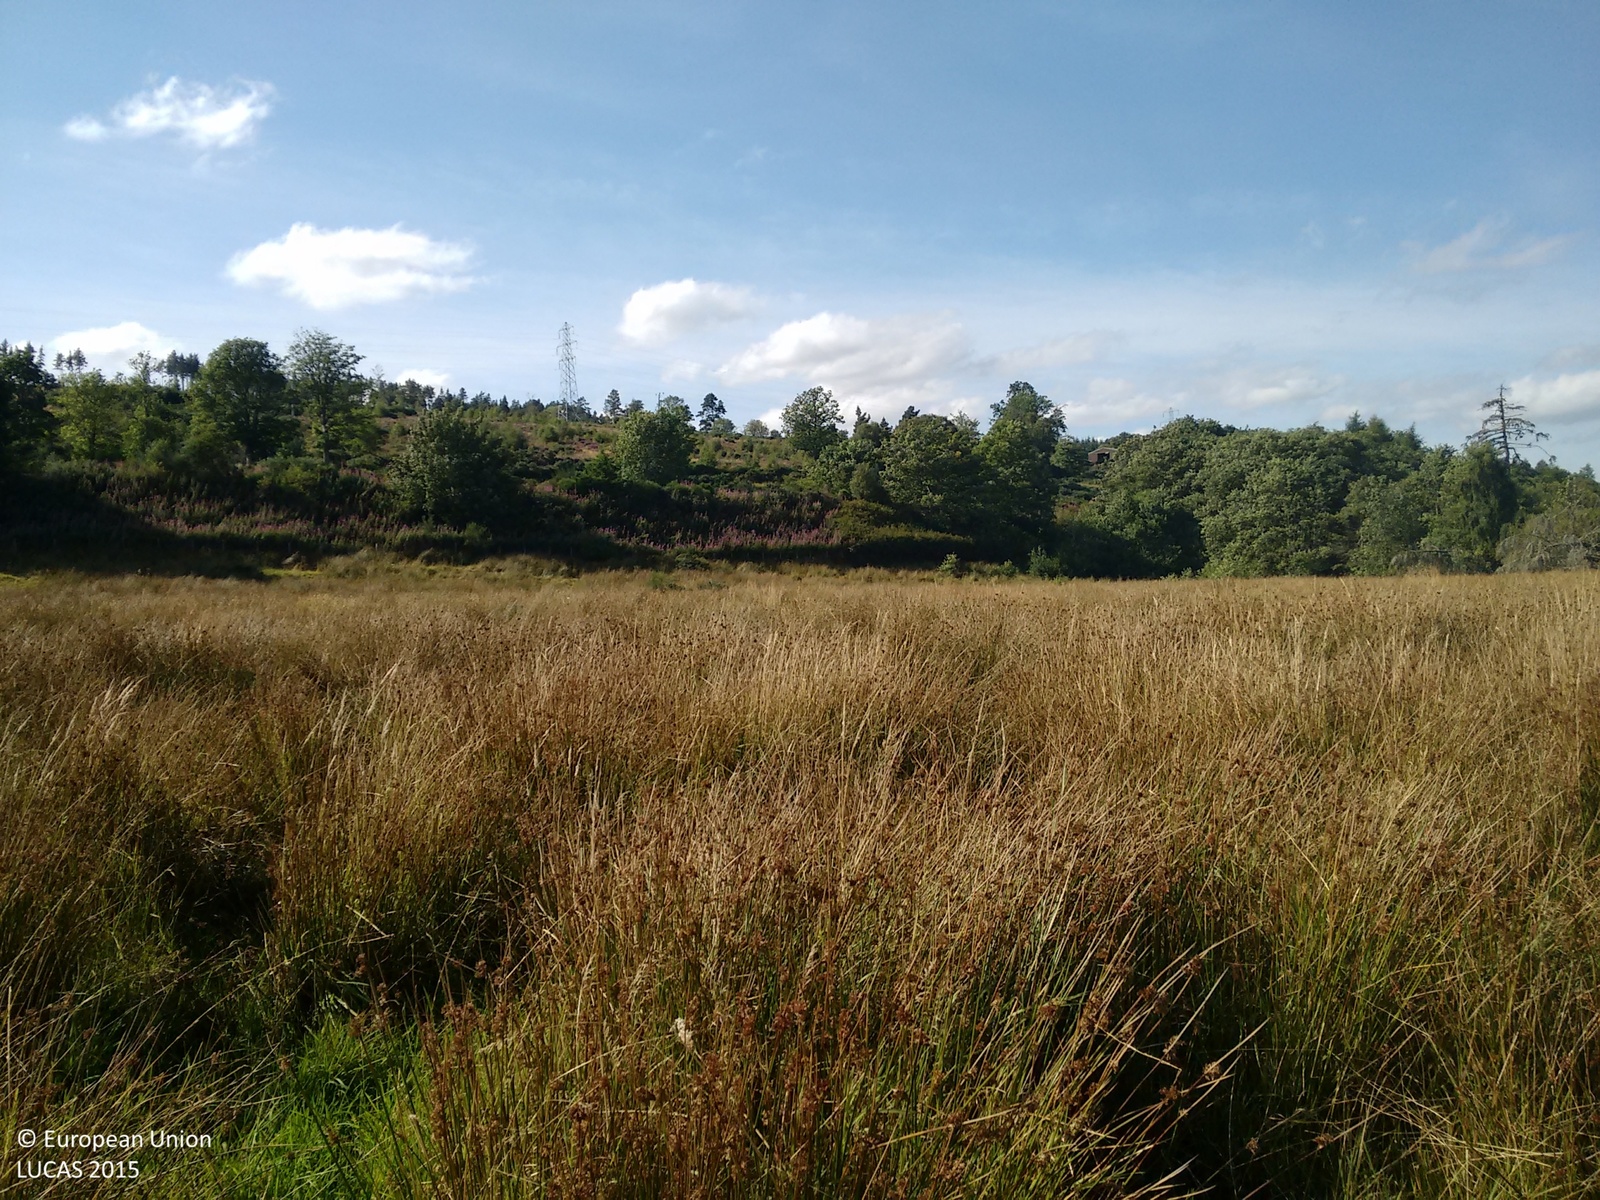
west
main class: Grassland
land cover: Grassland without tree/shrub cover
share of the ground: > 75 %
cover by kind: herbaceous plants 100 %
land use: Agriculture (excluding fallow land and kitchen gardens)
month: September
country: GB
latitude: 57.8987
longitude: -4.3763
